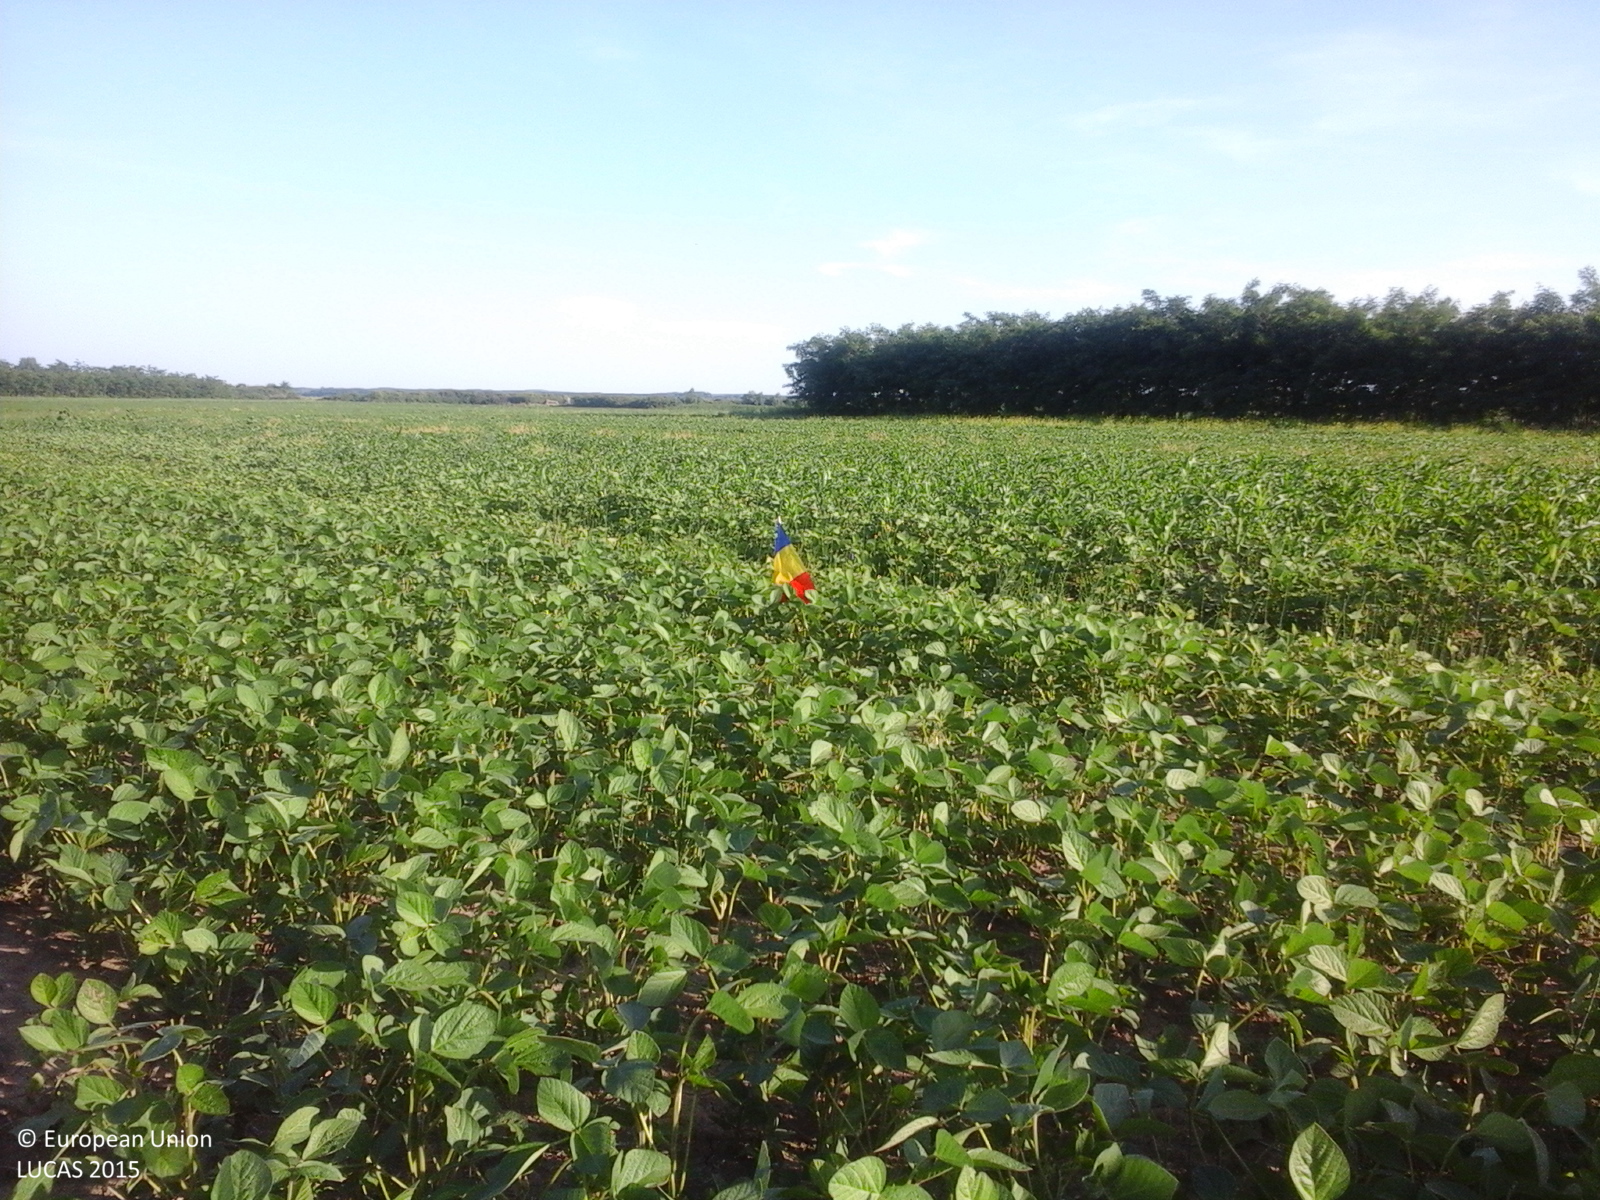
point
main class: Cropland
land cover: Soya
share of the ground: > 75 %
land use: Agriculture (excluding fallow land and kitchen gardens)
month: June
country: RO
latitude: 47.7684
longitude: 27.2587
